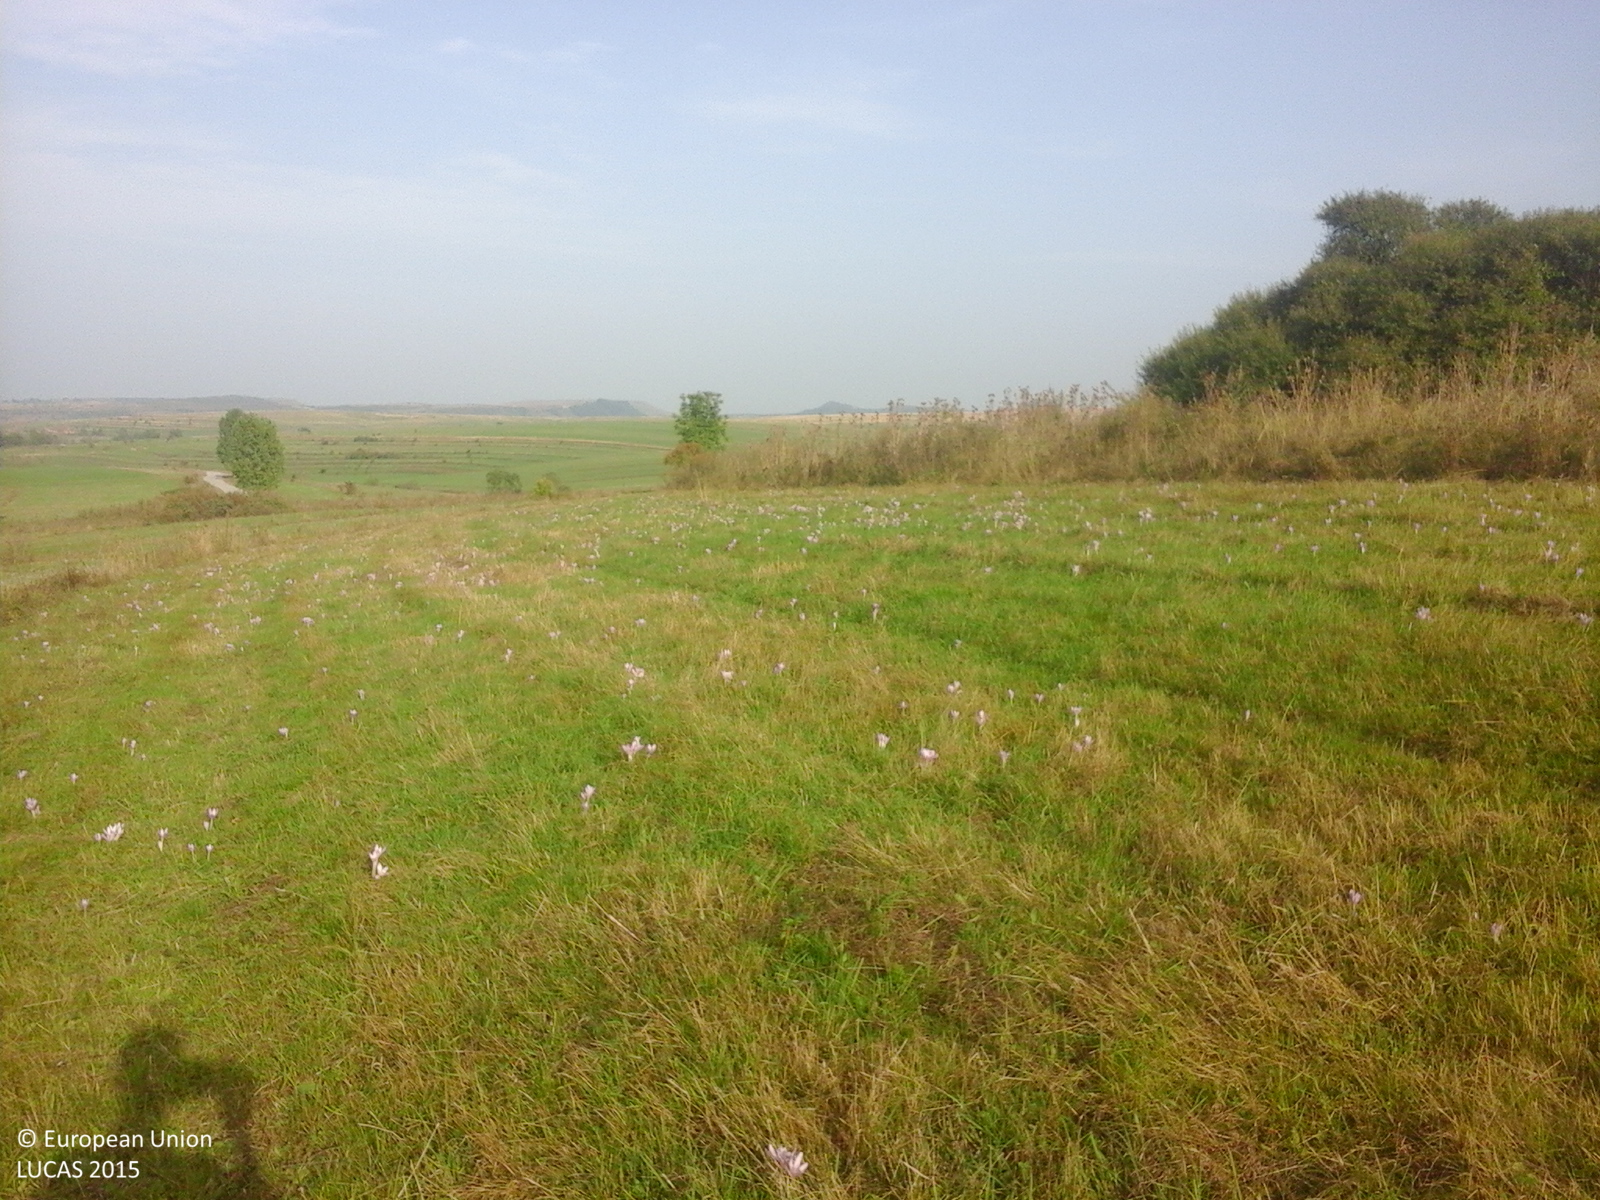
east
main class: Grassland
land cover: Grassland without tree/shrub cover
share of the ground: > 75 %
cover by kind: herbaceous plants 100 %
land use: Agriculture (excluding fallow land and kitchen gardens)
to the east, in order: Grassland without tree/shrub cover; Spontaneously vegetated surfaces; Grassland without tree/shrub cover
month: September
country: RO
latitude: 46.7801
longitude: 22.9614
